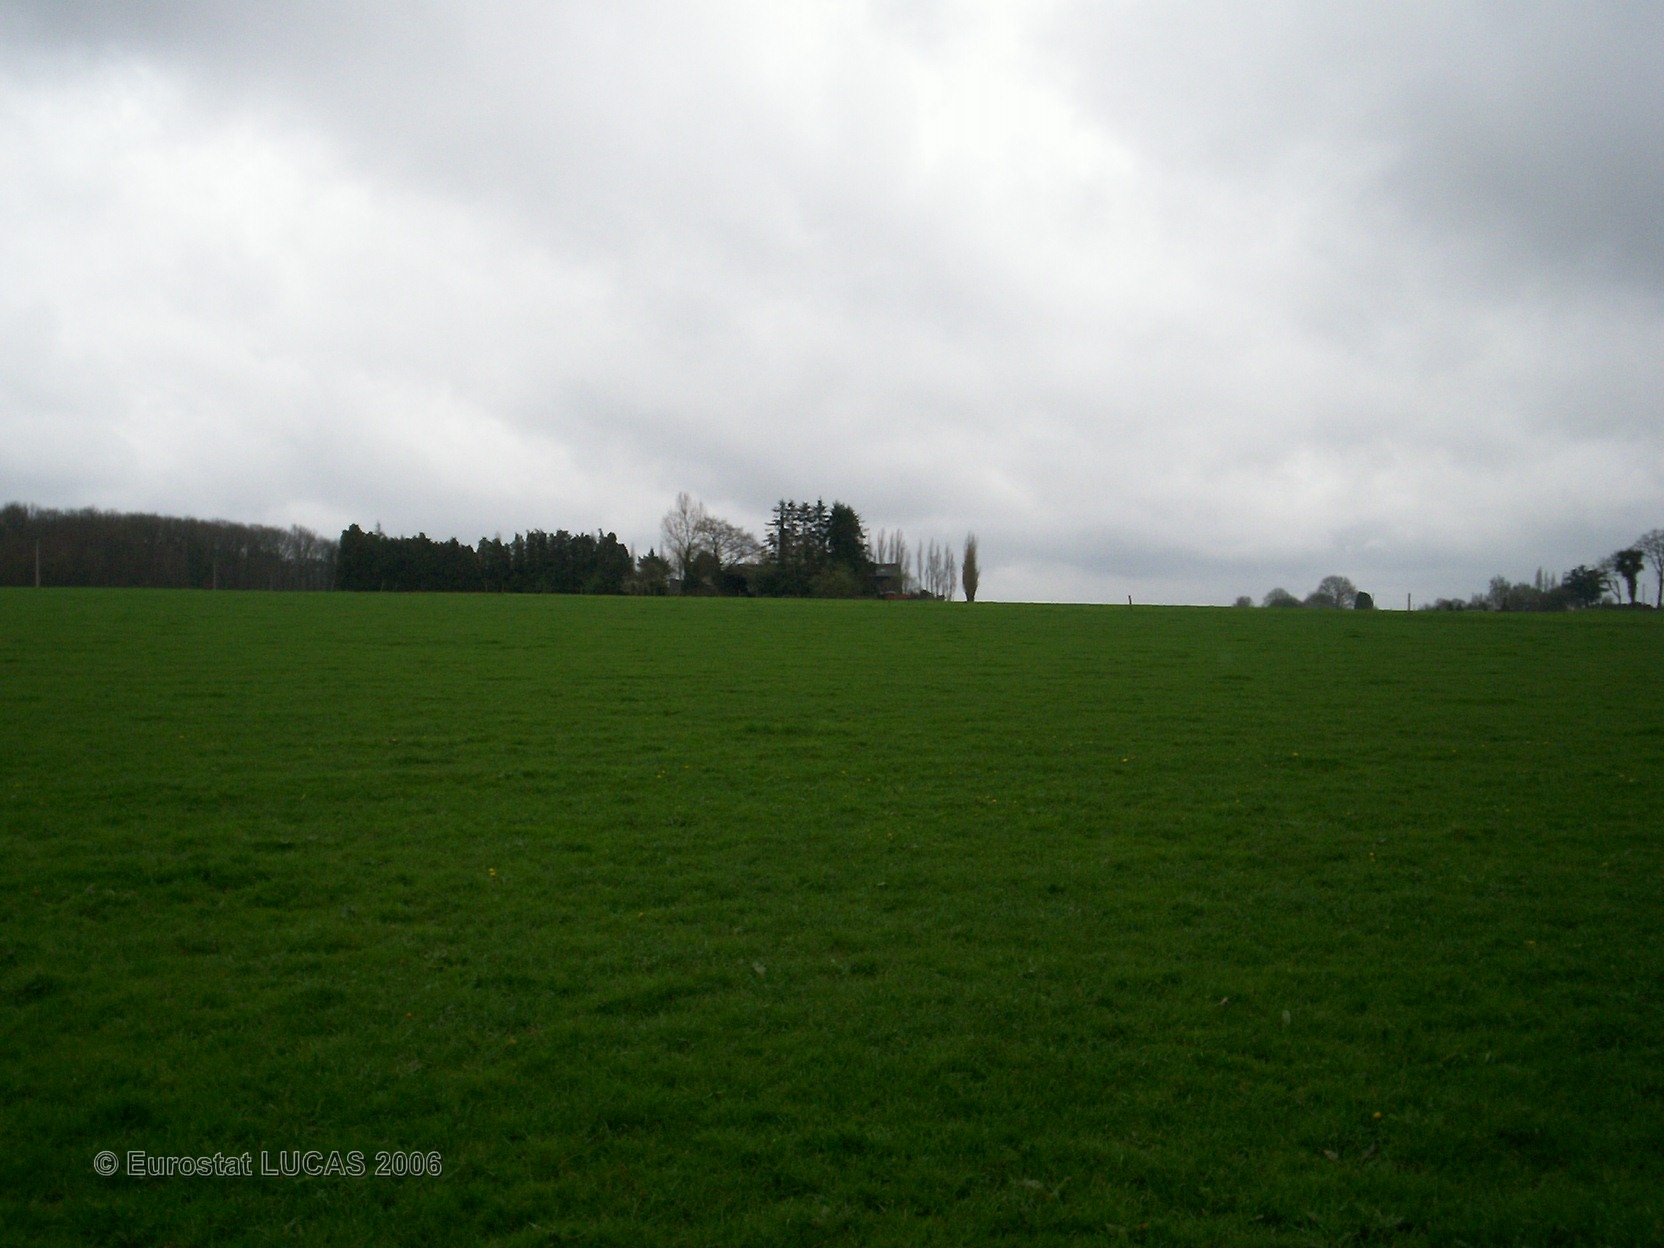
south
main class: Grassland
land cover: Grassland without tree/shrub cover
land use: Agriculture (excluding fallow land and kitchen gardens)
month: April
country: FR
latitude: 47.8821
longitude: -2.8893
